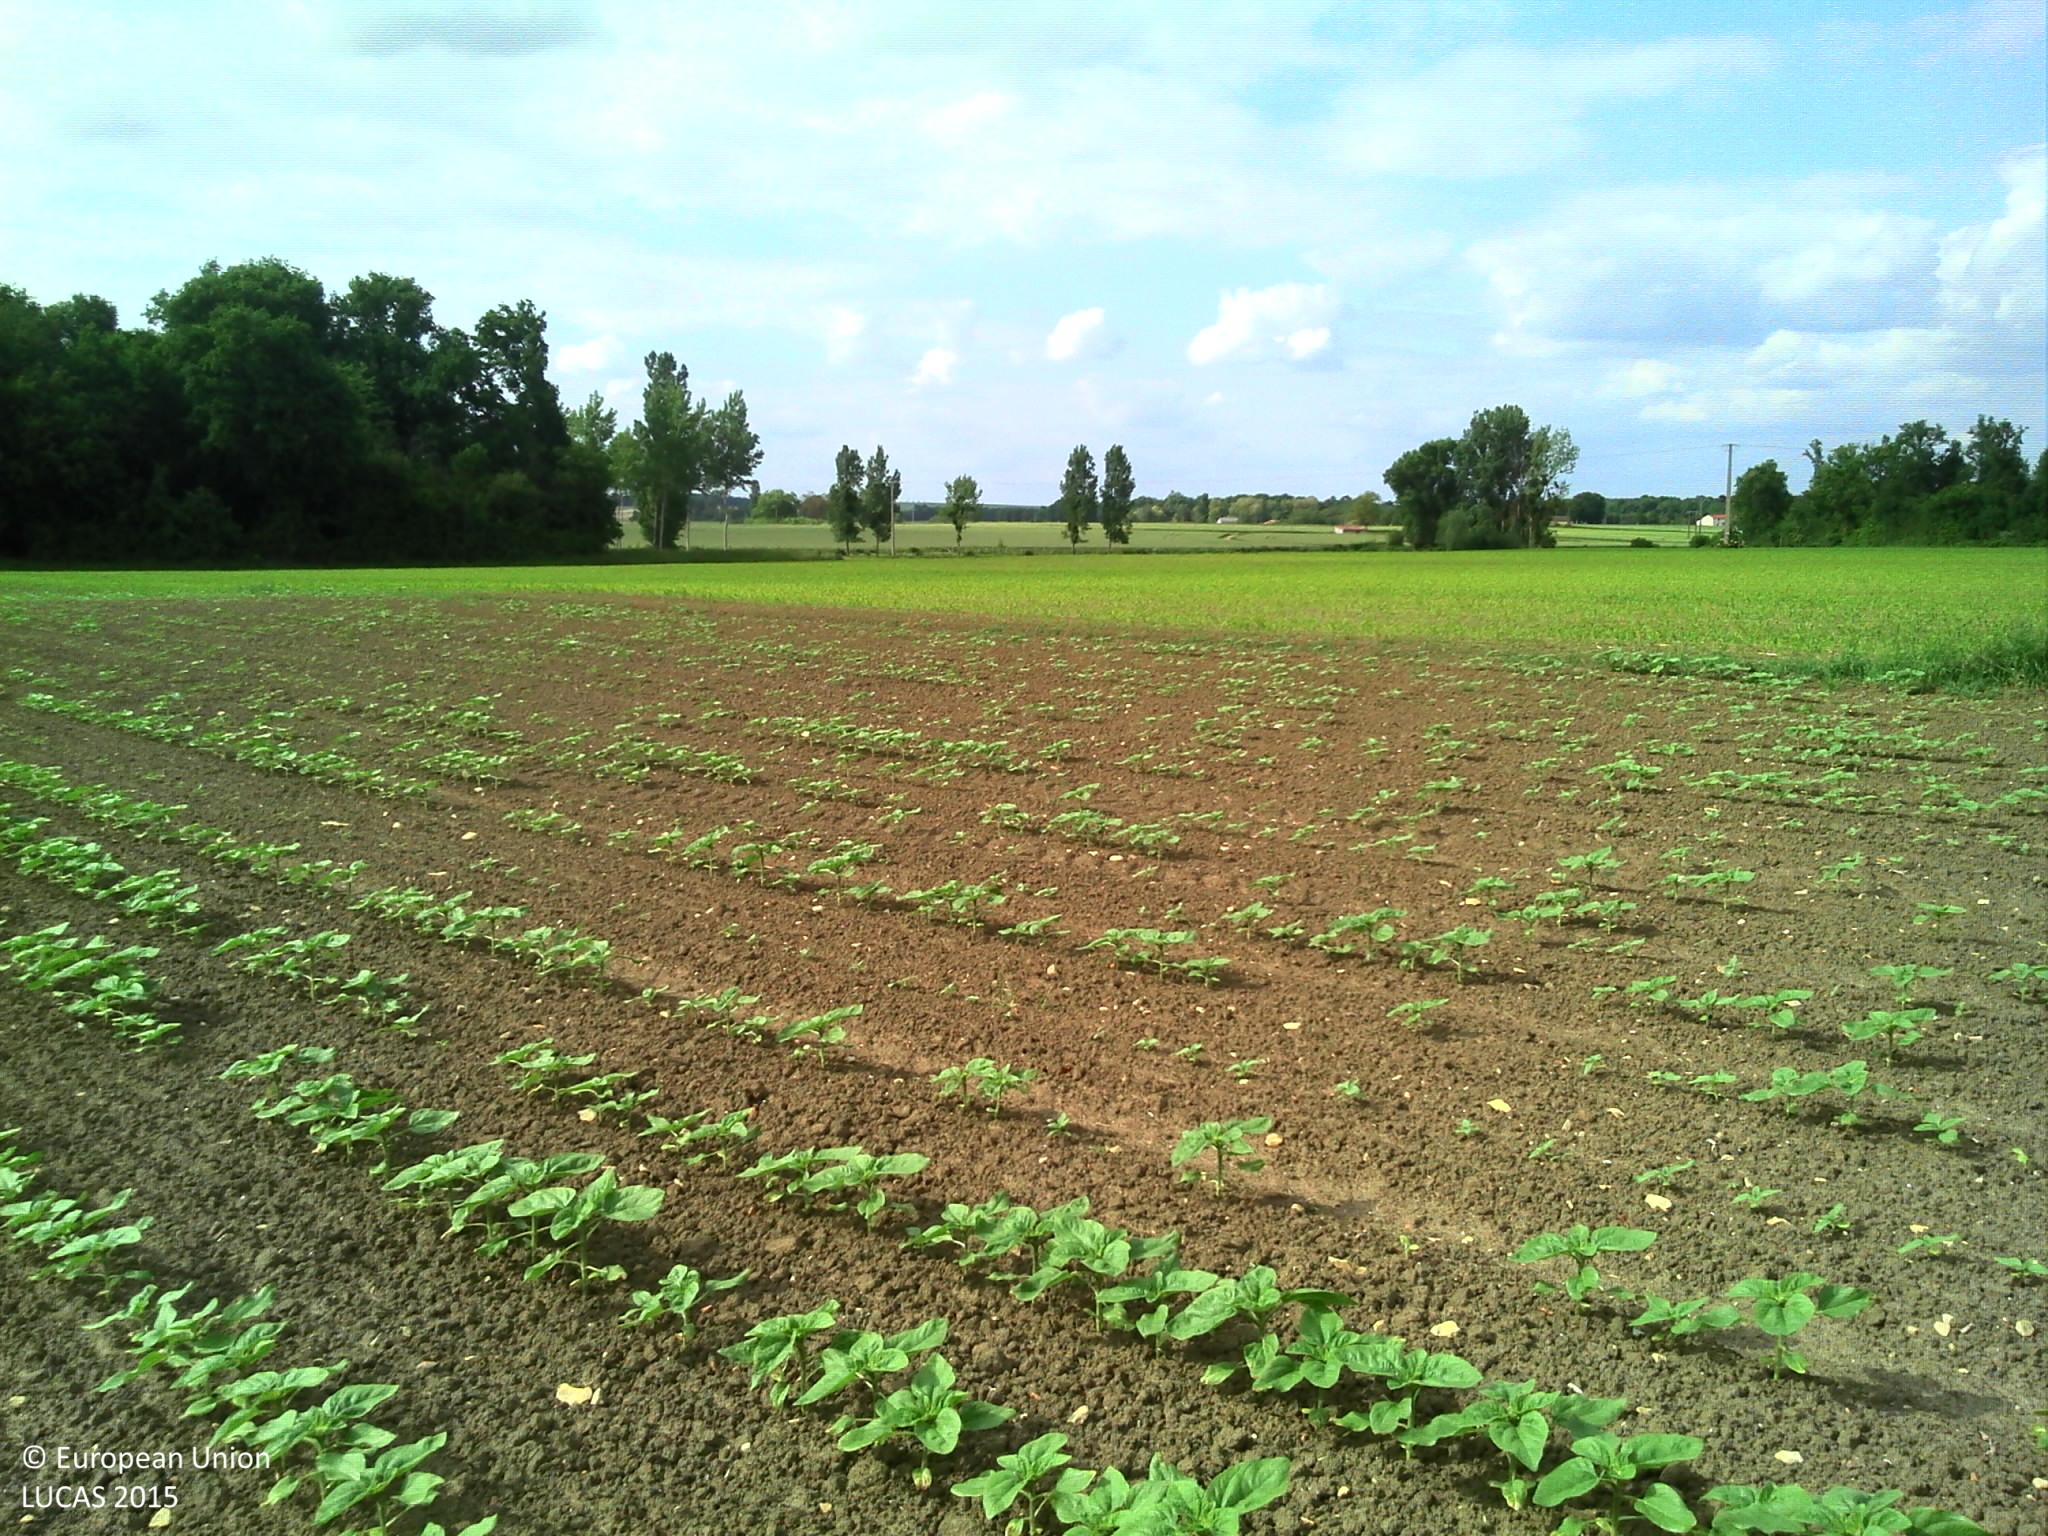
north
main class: Cropland
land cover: Sunflower
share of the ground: 10 - 25 %
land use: Agriculture (excluding fallow land and kitchen gardens)
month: May
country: FR
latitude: 46.8286
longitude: 0.2387
